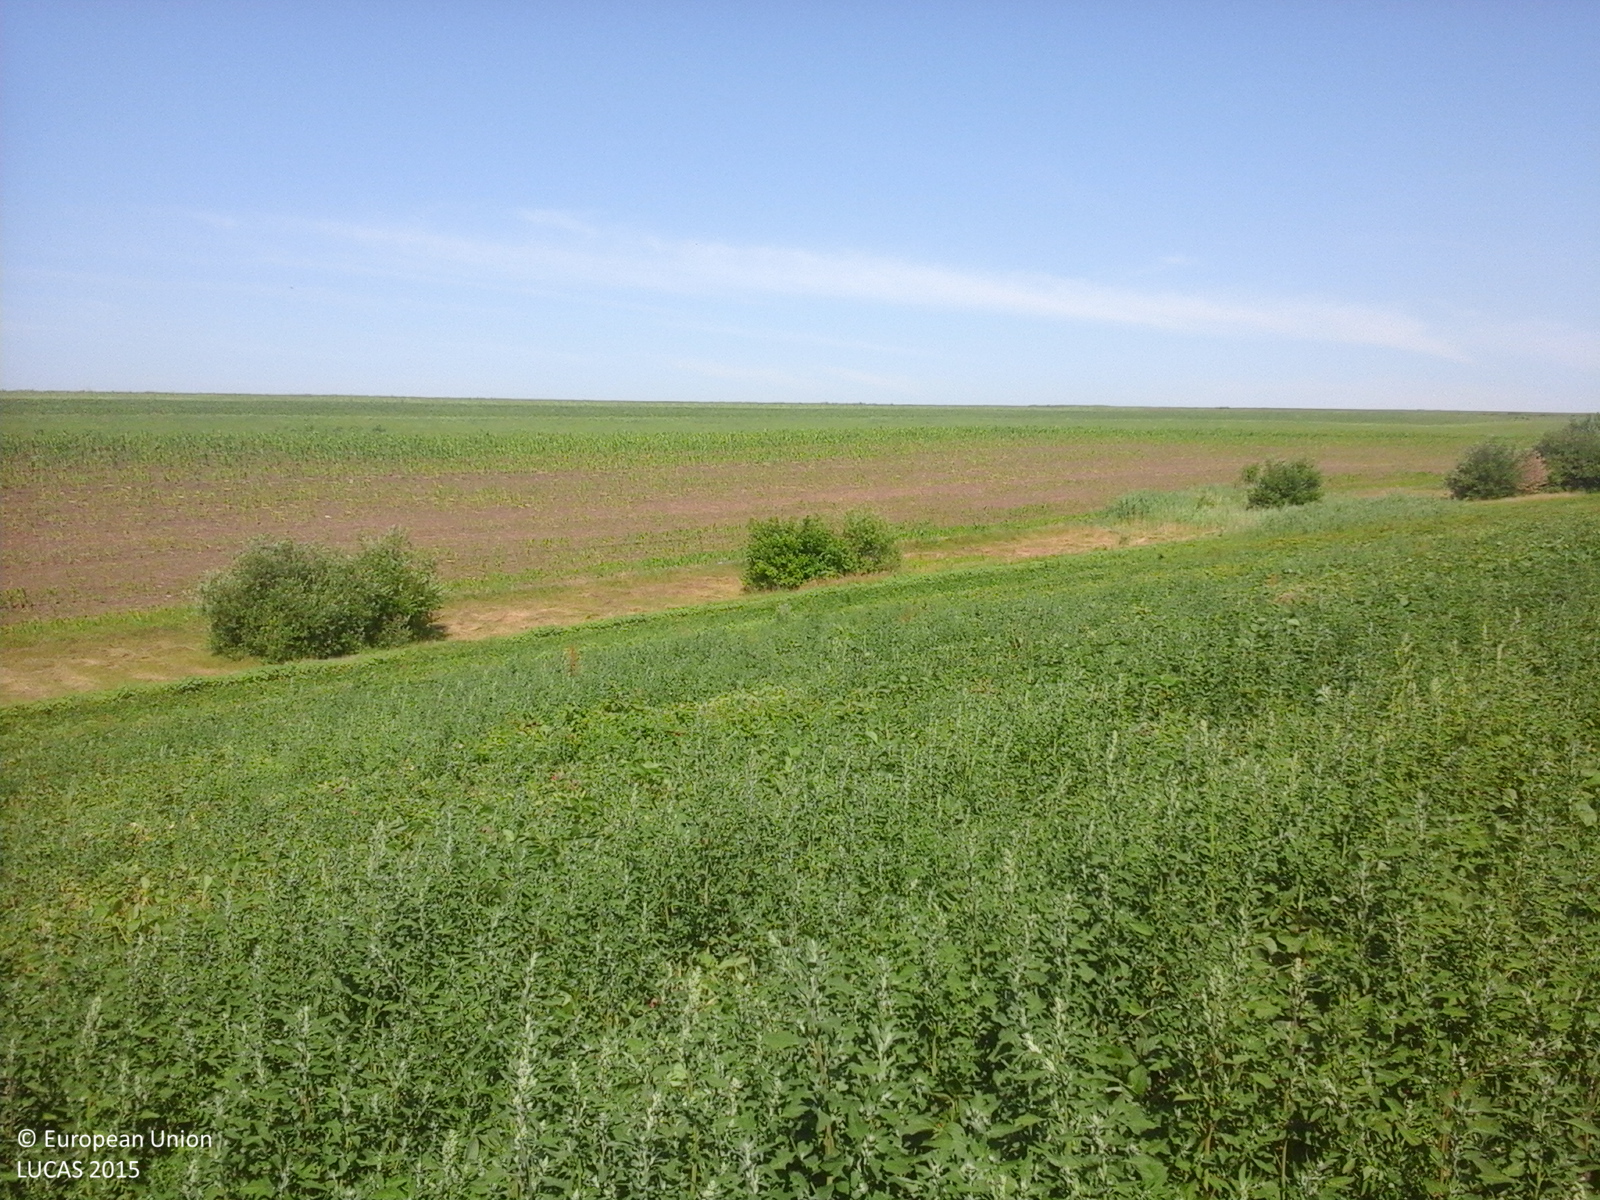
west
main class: Cropland
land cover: Soya
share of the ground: 25 - 50 %
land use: Agriculture (excluding fallow land and kitchen gardens)
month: June
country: RO
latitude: 47.7584
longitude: 27.0902
